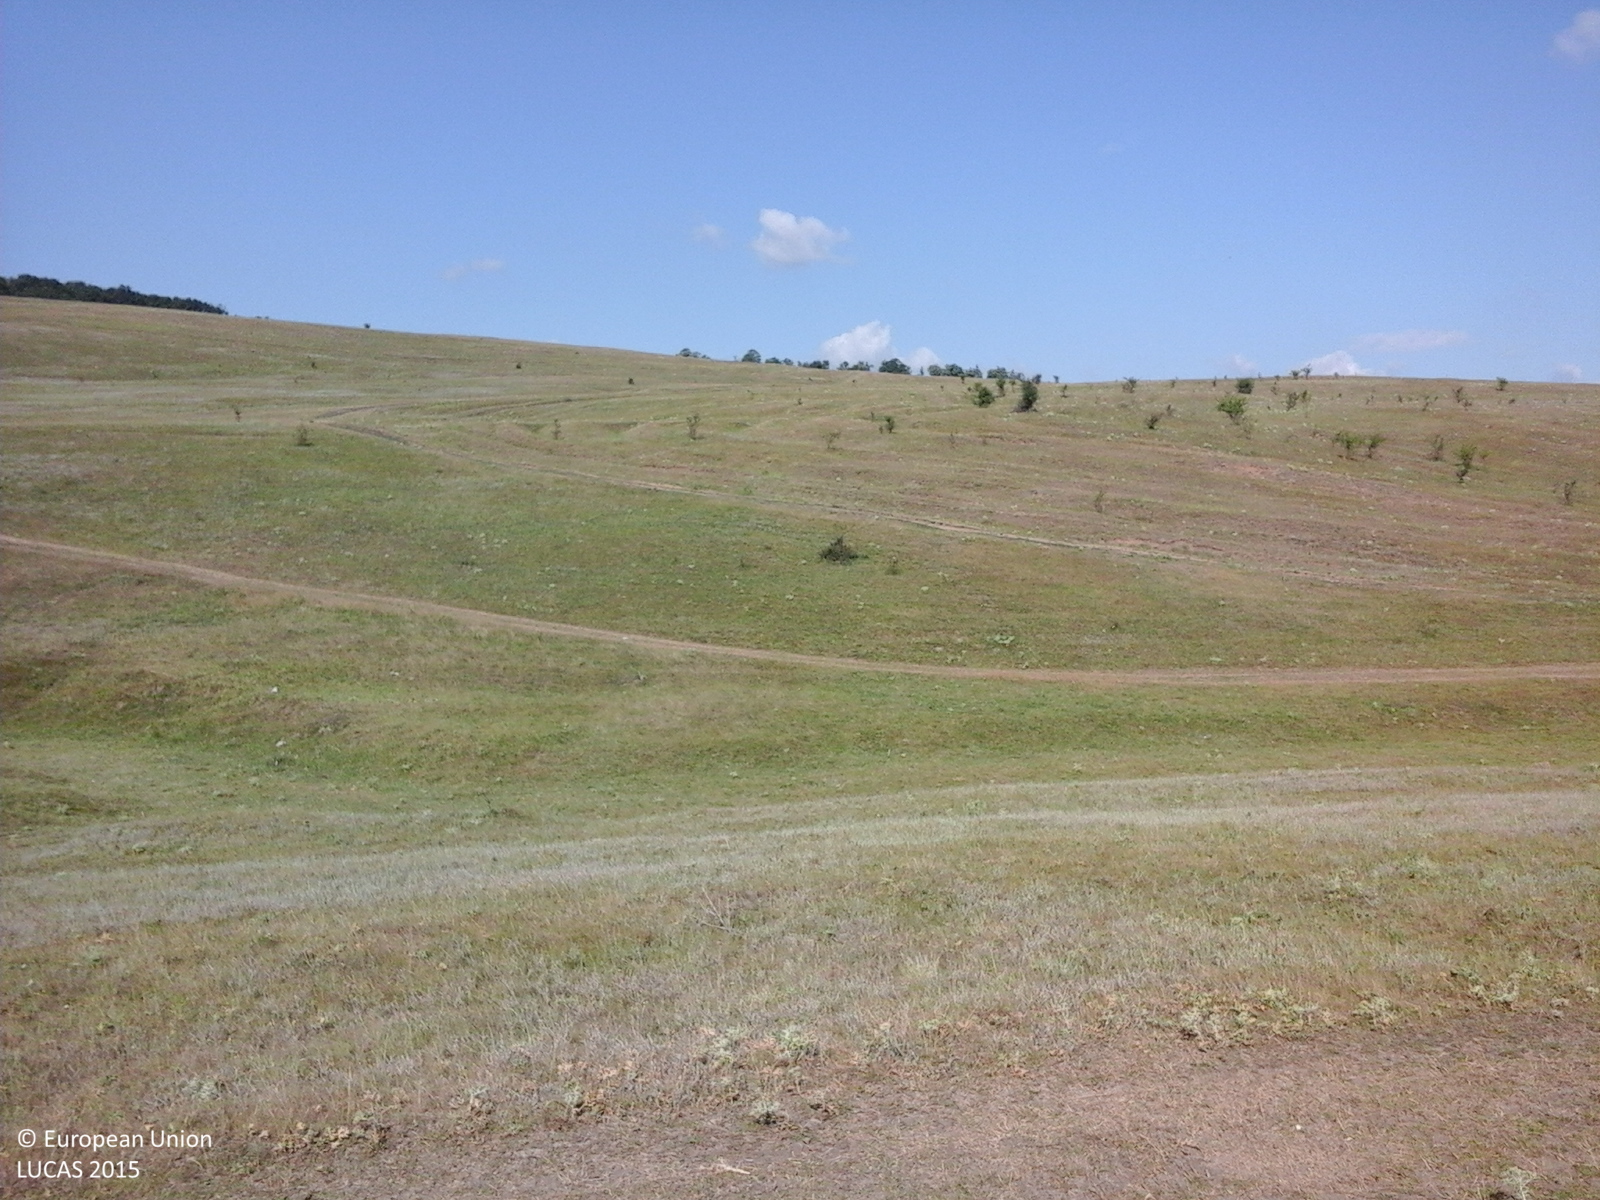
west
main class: Grassland
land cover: Grassland without tree/shrub cover
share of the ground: > 75 %
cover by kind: herbaceous plants 100 %
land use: Agriculture (excluding fallow land and kitchen gardens)
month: July
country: RO
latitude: 46.0696
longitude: 27.7362
